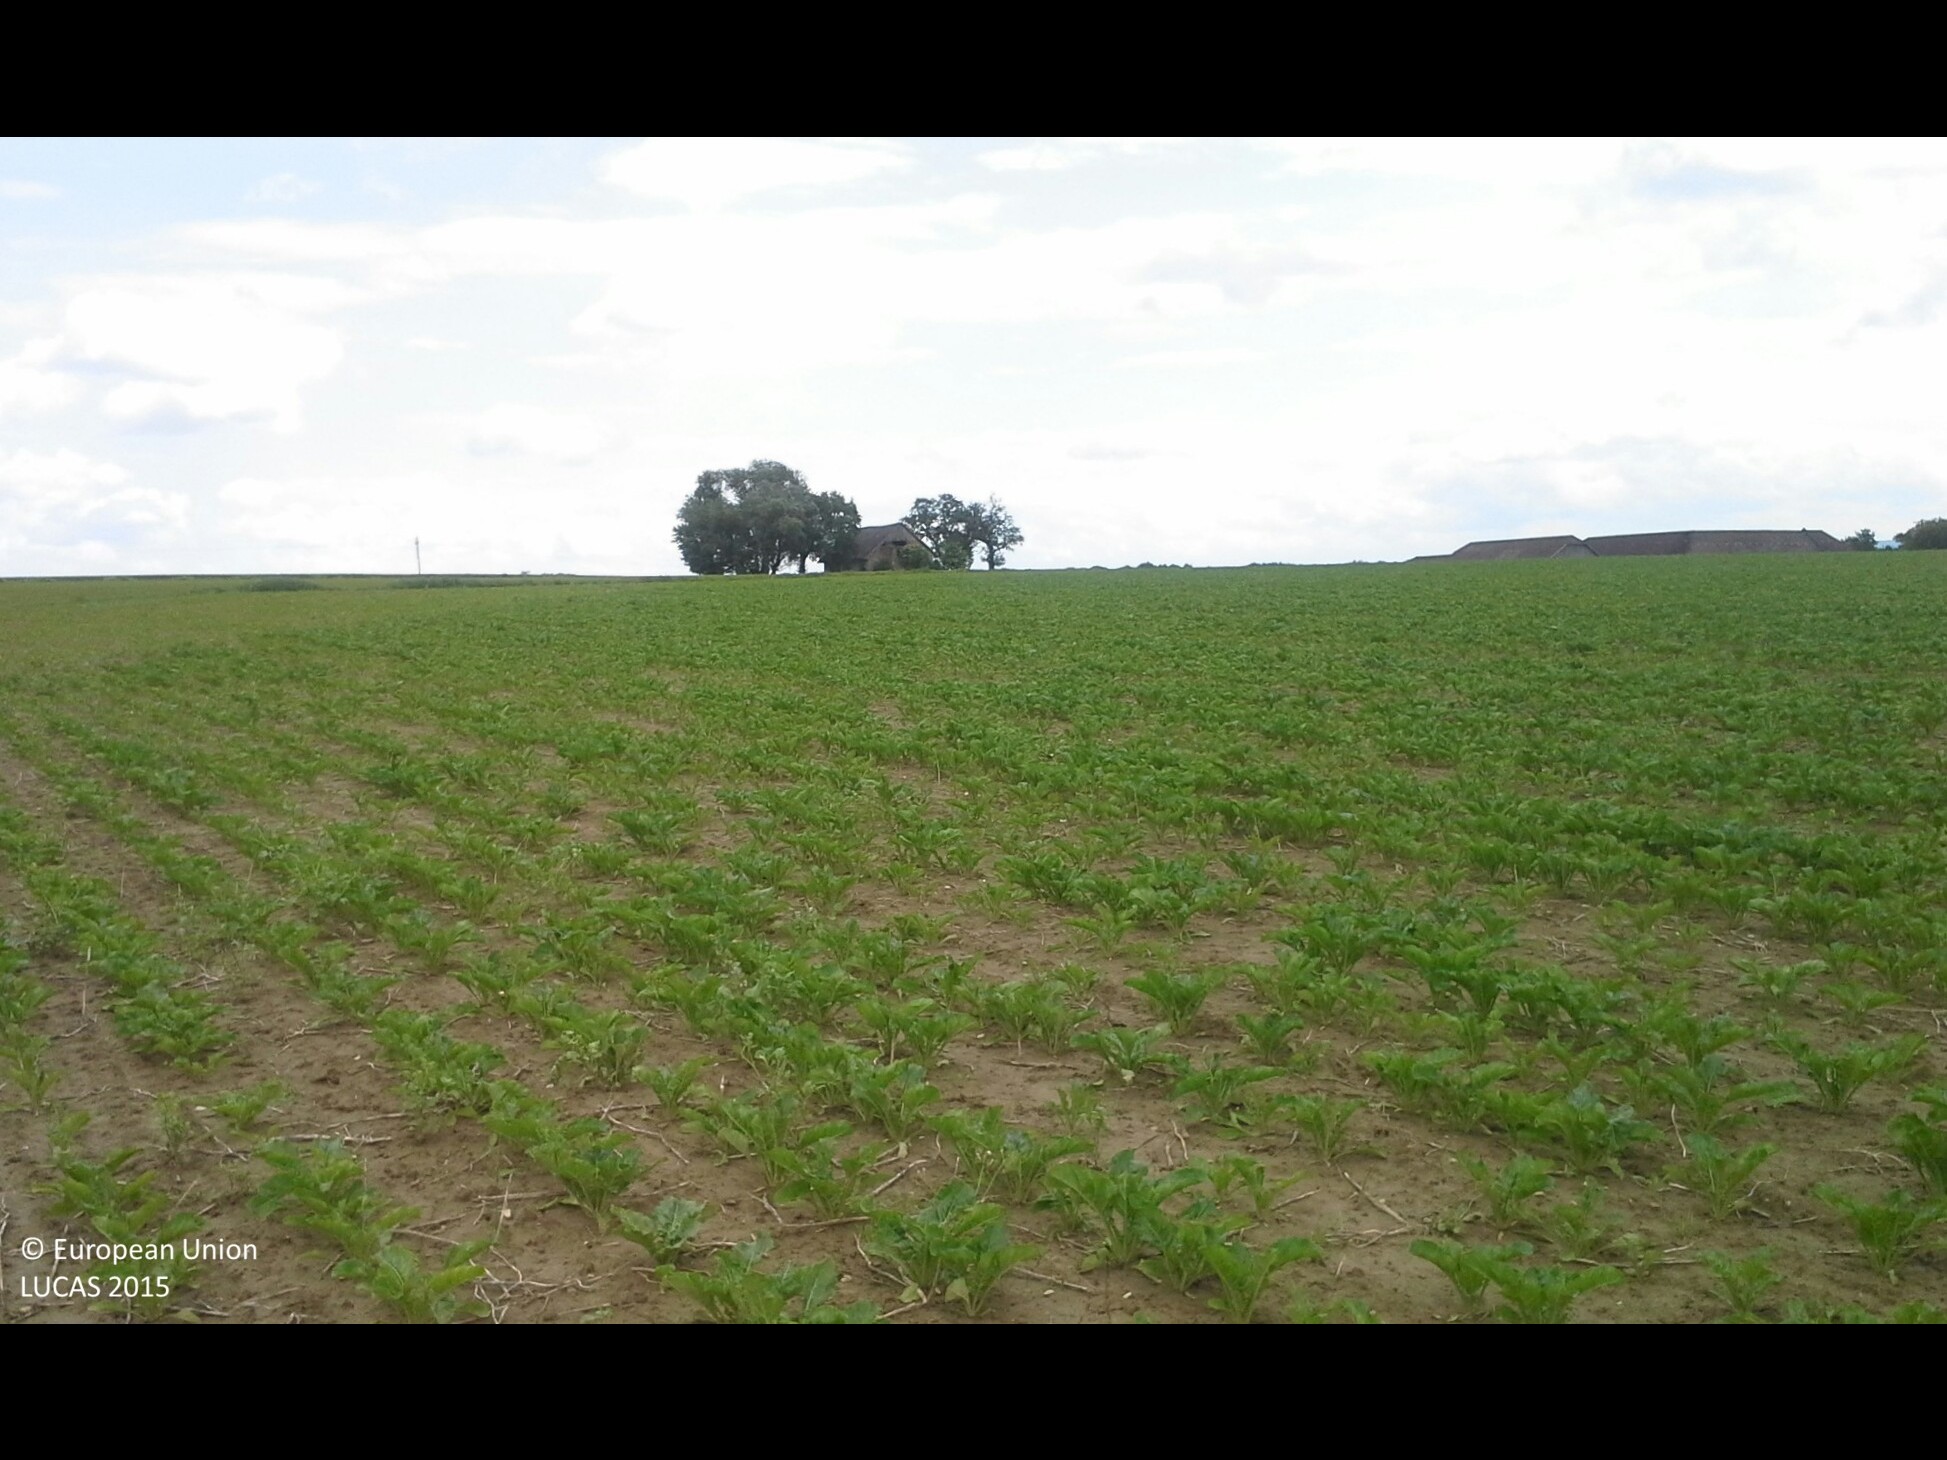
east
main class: Cropland
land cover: Sugar beet
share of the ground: 25 - 50 %
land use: Agriculture (excluding fallow land and kitchen gardens)
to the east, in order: Sugar beet; Grass margins; Soya; Grass margins; Paved roads, cycling and walking lanes; Grass margins; Common wheat
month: May
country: AT
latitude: 48.1170
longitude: 14.4195
